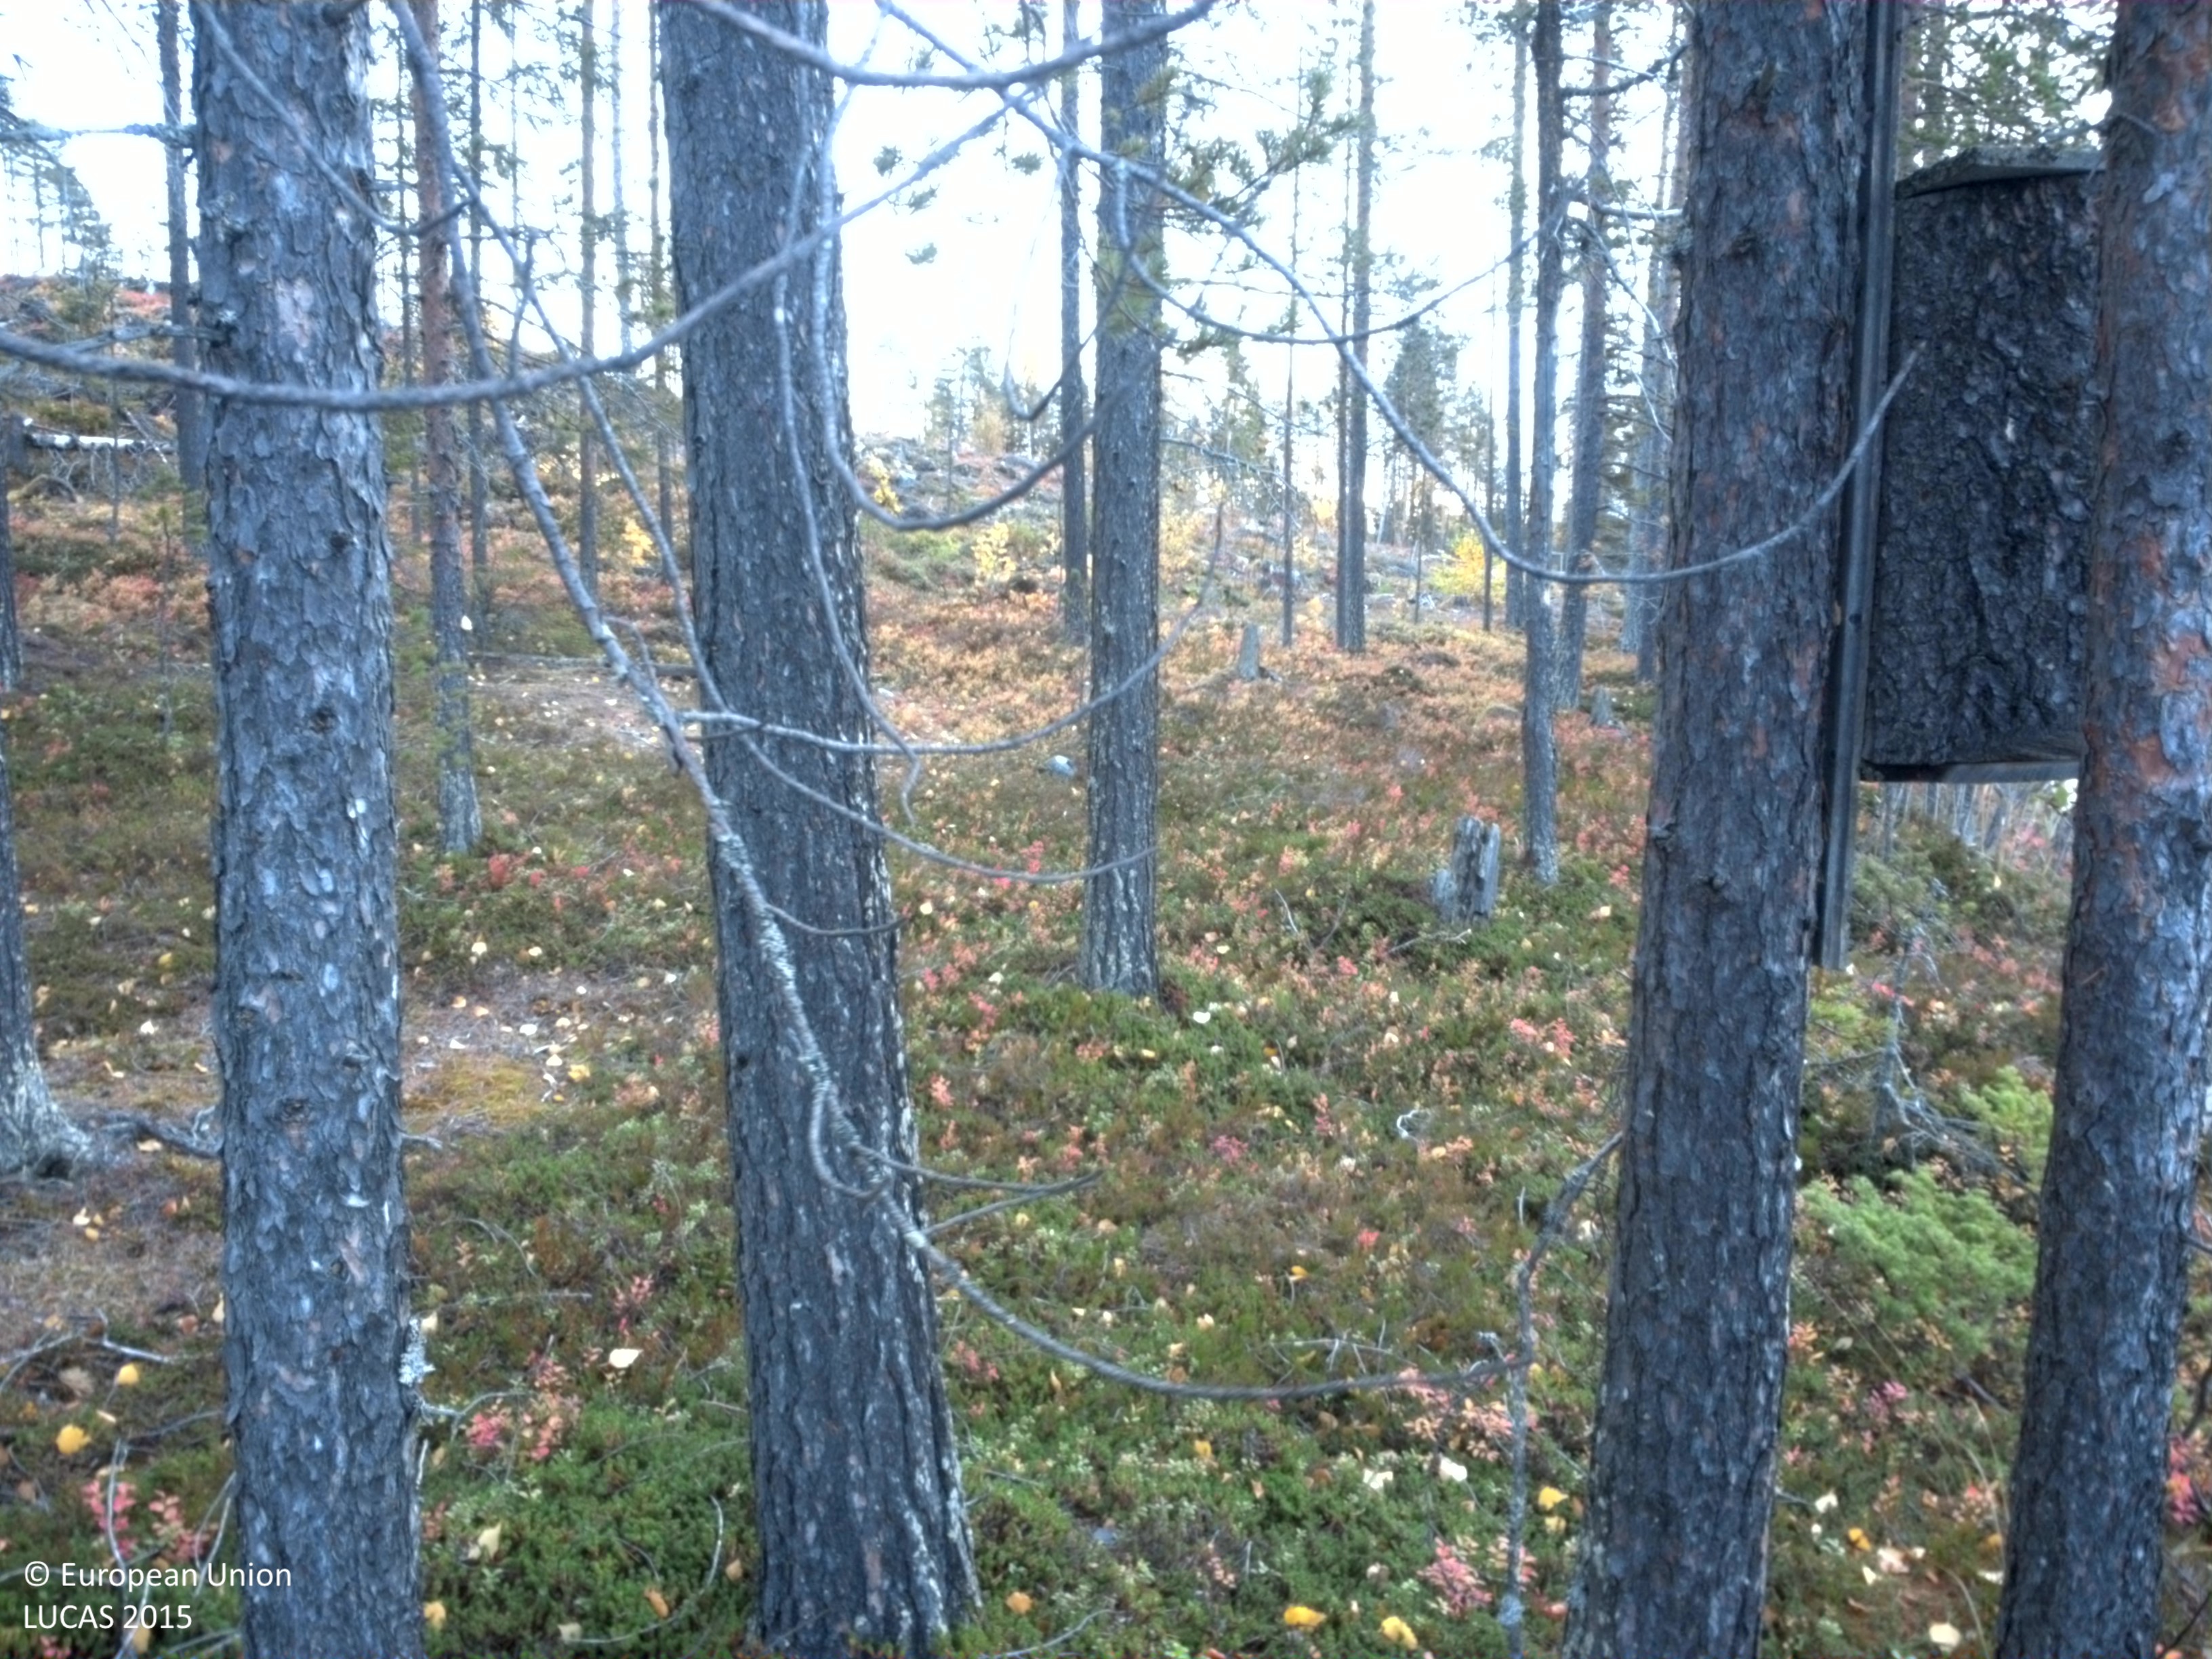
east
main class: Woodland
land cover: Pine dominated coniferous woodland
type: boreal forest
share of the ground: 25 - 50 %
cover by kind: shrubs 45 %, coniferous forest trees 40 %, lichens and mosses 10 %, broadleaved forest trees 5 %
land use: Forestry
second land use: Residential
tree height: > 5 m
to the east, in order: Pine dominated coniferous woodland; Shrubland with sparse tree cover; Other mixed woodland; Tracks; Other coniferous woodland; Spruce dominated mixed woodland
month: October
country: SE
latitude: 65.0576
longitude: 17.4653
